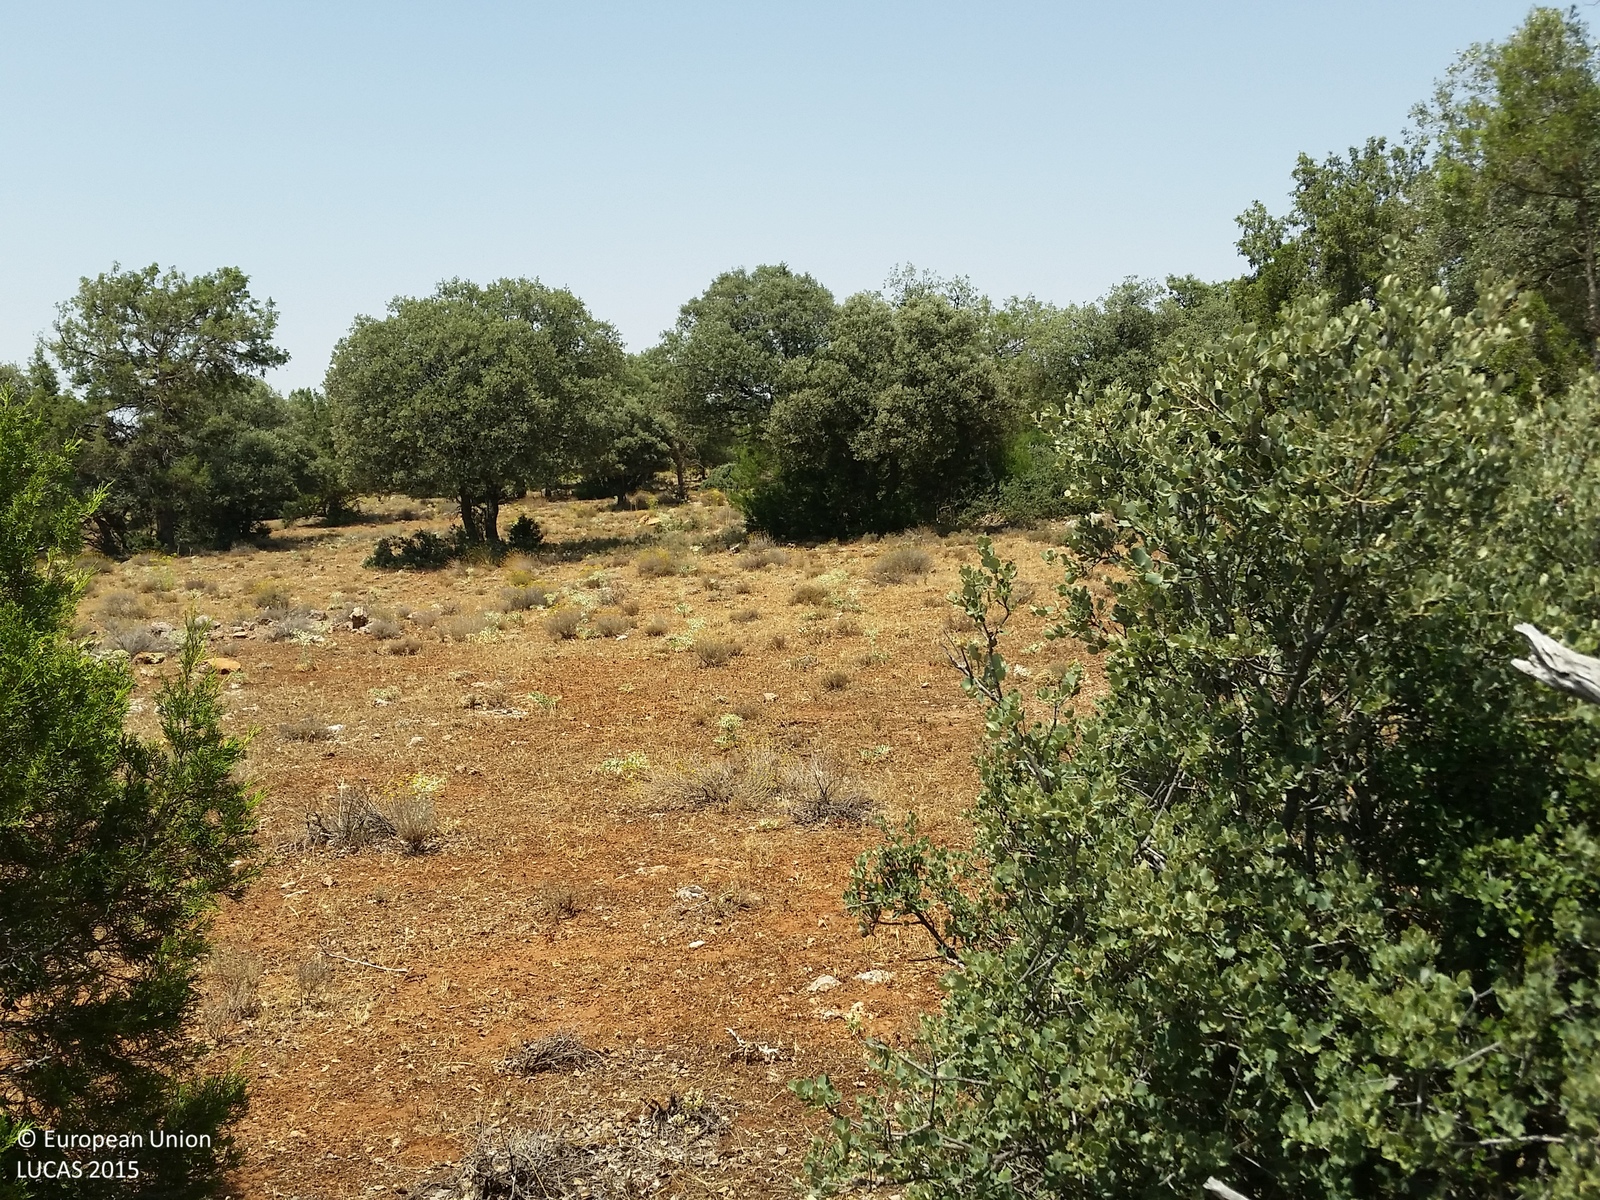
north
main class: Woodland
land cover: Pine dominated mixed woodland
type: coniferous forest of the mediterranean region
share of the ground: > 75 %
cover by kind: shrubs 30 %, coniferous forest trees 25 %, herbaceous plants 20 %, broadleaved forest trees 15 %, consolidated bare surface 10 %
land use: Semi-natural and natural areas not in use
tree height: > 5 m
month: June
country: ES
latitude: 38.8062
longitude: -2.4972
